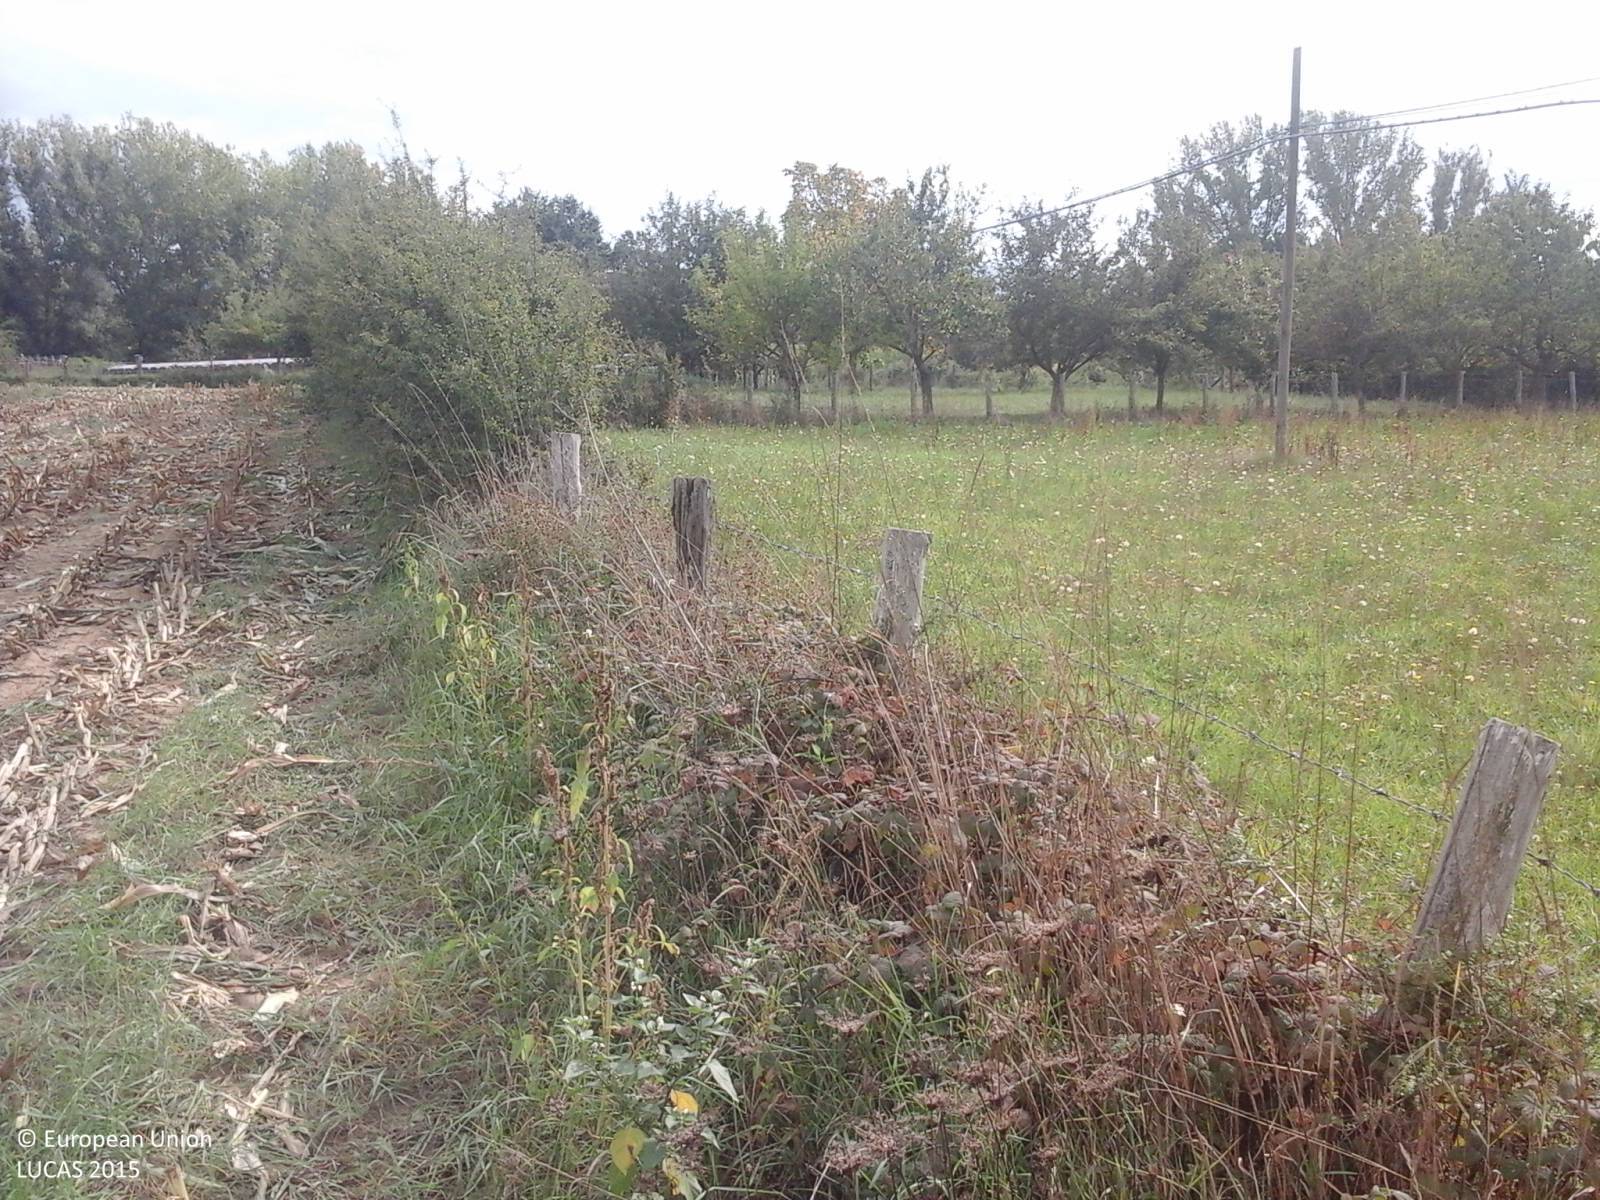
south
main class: Cropland
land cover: Temporary grasslands
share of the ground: > 75 %
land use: Agriculture (excluding fallow land and kitchen gardens)
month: October
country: IT
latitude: 42.6546
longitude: 13.2958
